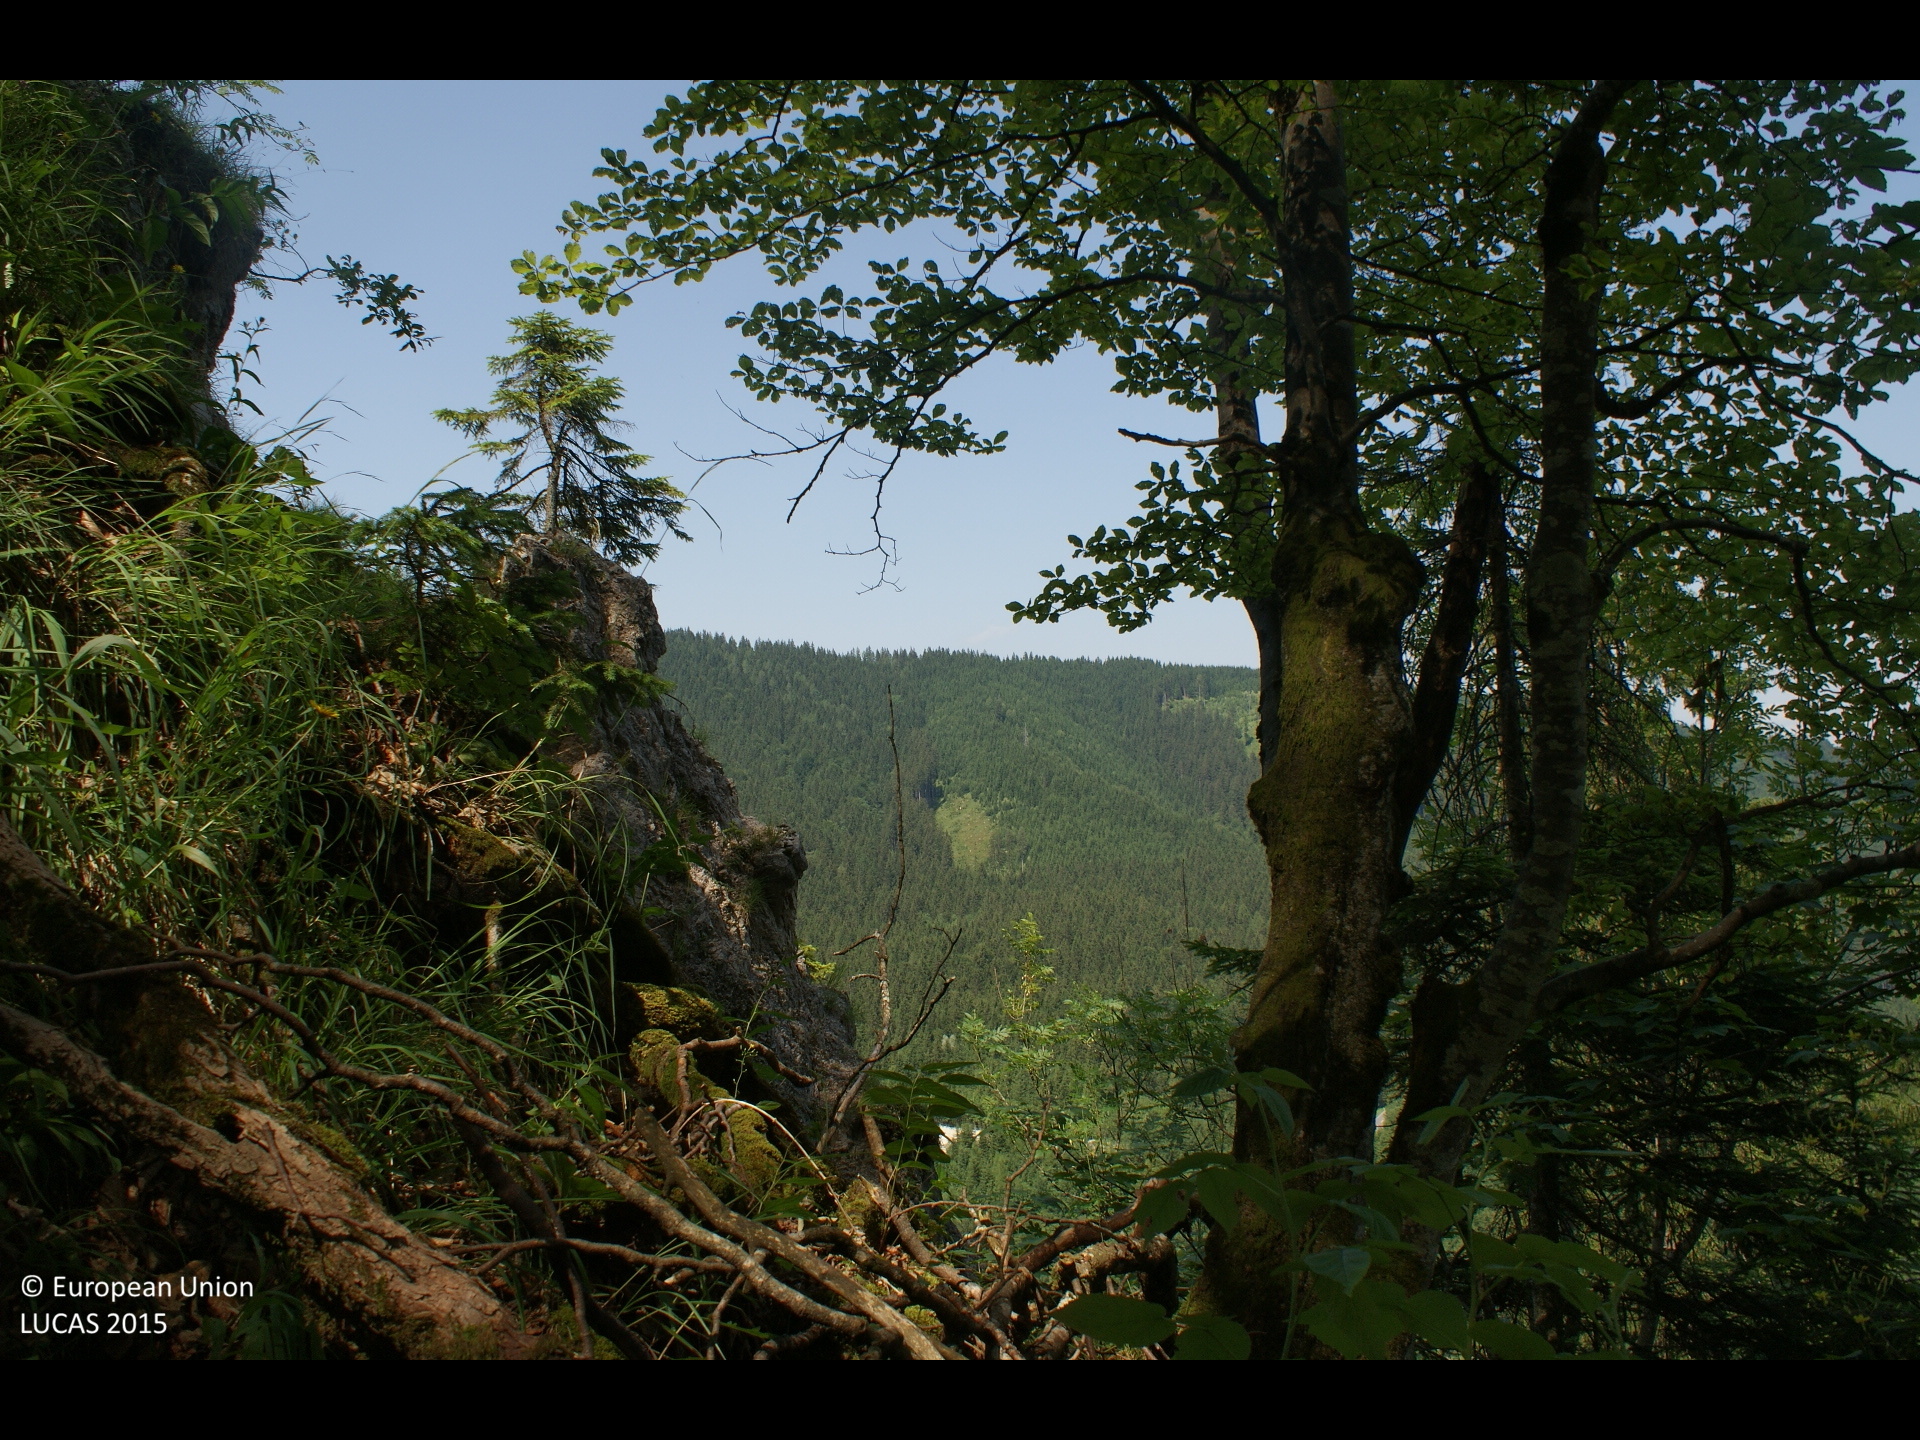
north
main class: Woodland
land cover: Spruce dominated mixed woodland
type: beech forest
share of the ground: > 75 %
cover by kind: broadleaved forest trees 60 %, coniferous forest trees 25 %, shrubs 5 %, herbaceous plants 5 %, consolidated bare surface 5 %
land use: Forestry
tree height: > 5 m
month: July
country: AT
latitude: 47.8399
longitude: 13.6198
